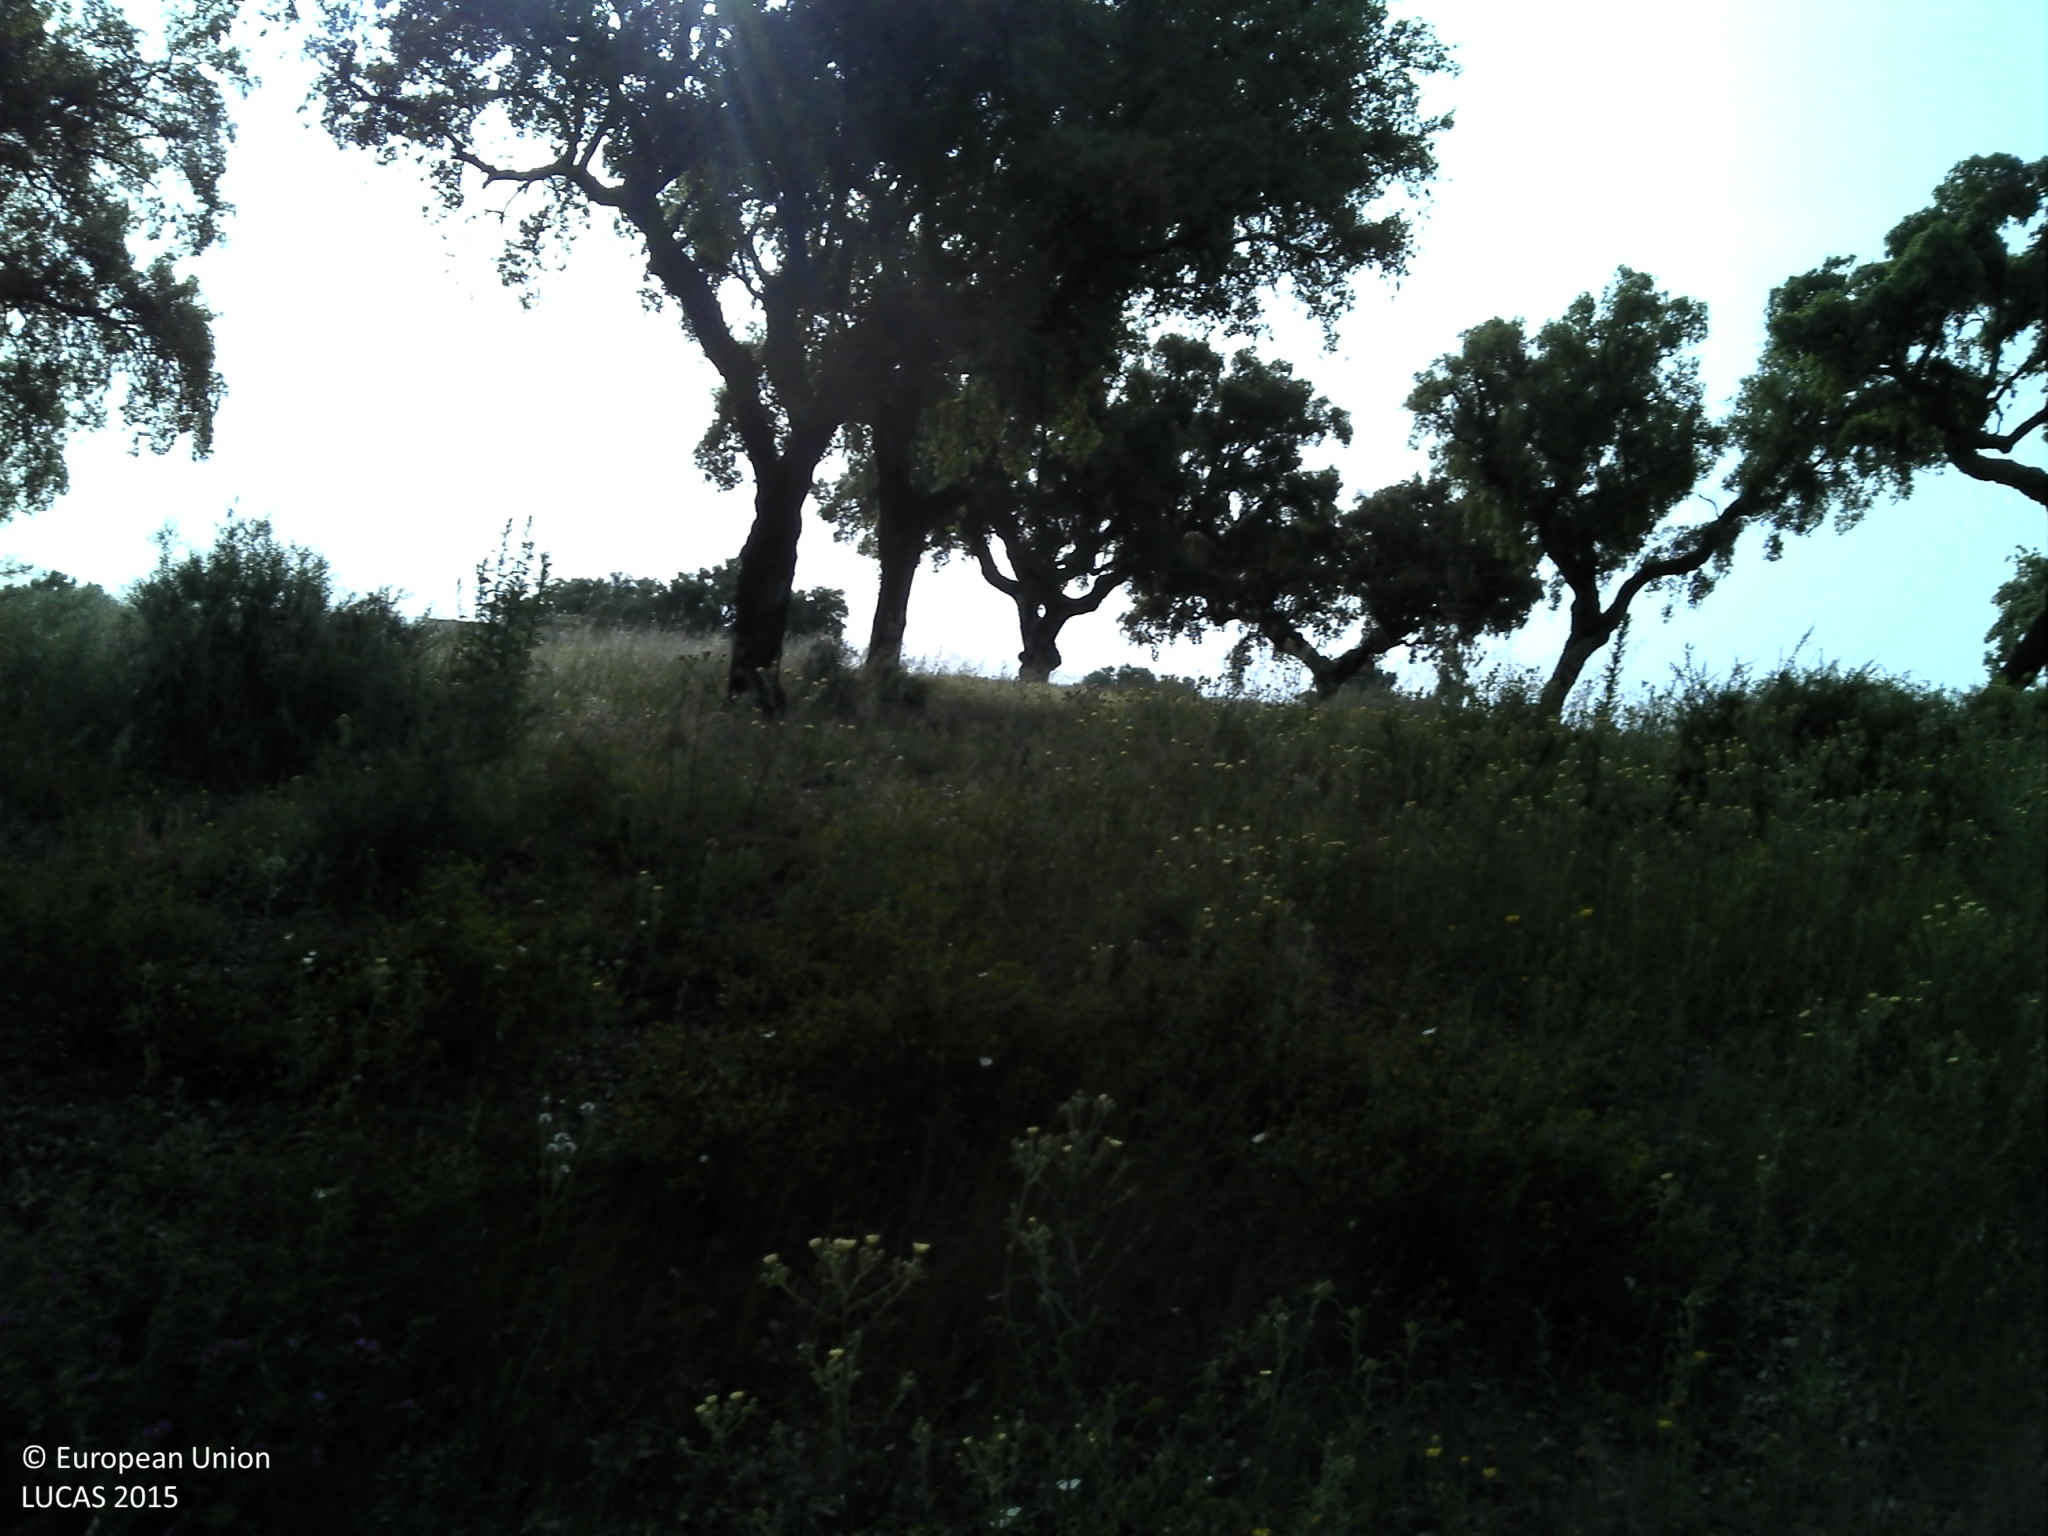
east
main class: Woodland
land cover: Broadleaved woodland
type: broadleaved evergreen forest
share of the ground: 25 - 50 %
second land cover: Shrubland without tree cover
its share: < 10 %
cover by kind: herbaceous plants 45 %, broadleaved forest trees 30 %, shrubs 15 %, unconsolidated bare surface 10 %
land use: Forestry
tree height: > 5 m
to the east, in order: Broadleaved woodland; Shrubland without tree cover; Broadleaved woodland; Fences; Broadleaved woodland
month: May
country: PT
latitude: 39.0936
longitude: -7.9601
